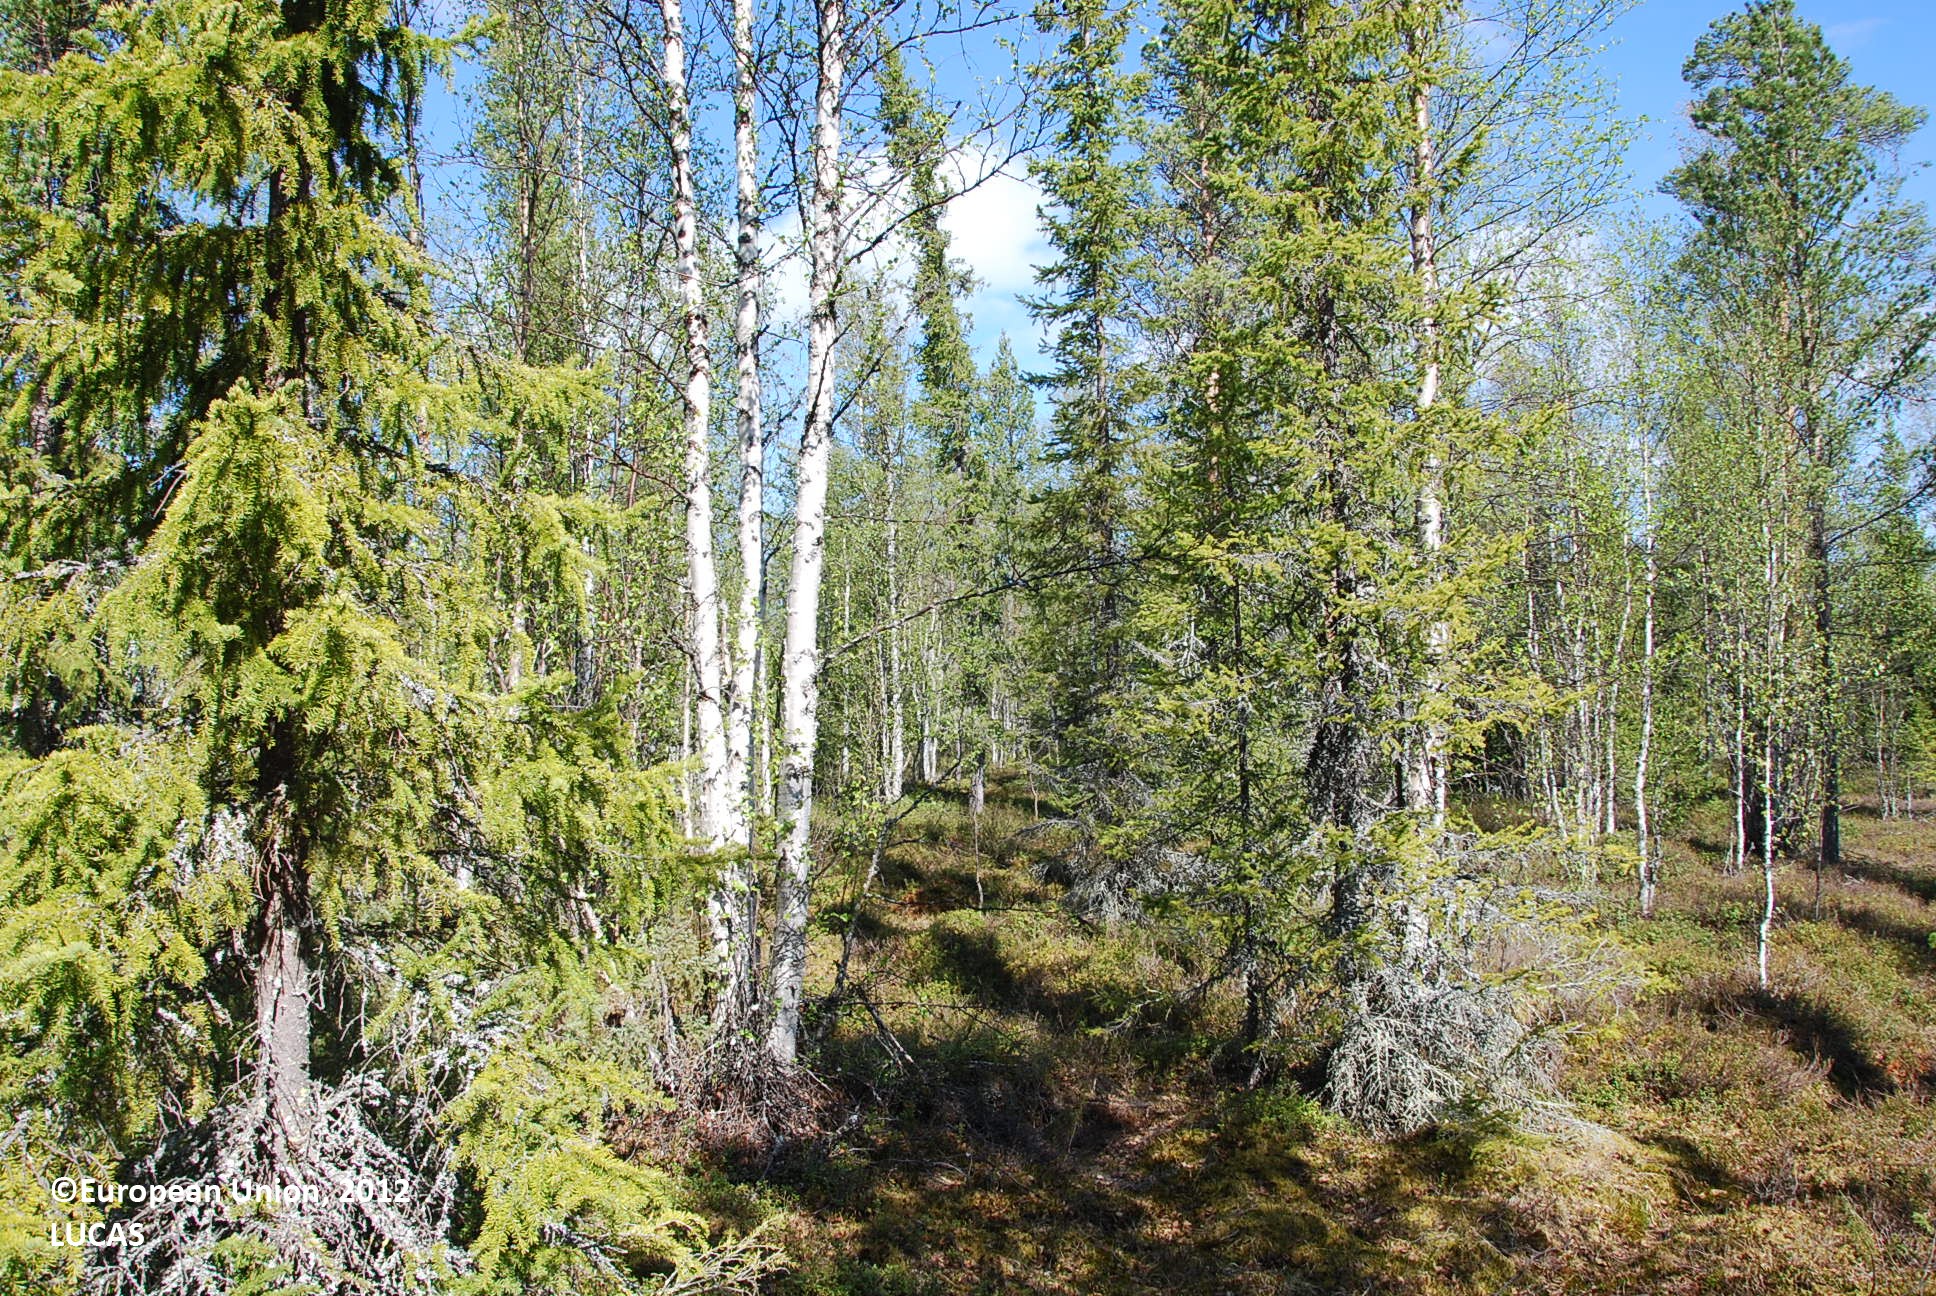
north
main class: Woodland
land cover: Other mixed woodland
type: boreal forest
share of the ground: > 75 %
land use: Forestry
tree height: > 5 m
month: June
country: FI
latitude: 67.0064
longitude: 28.0863
